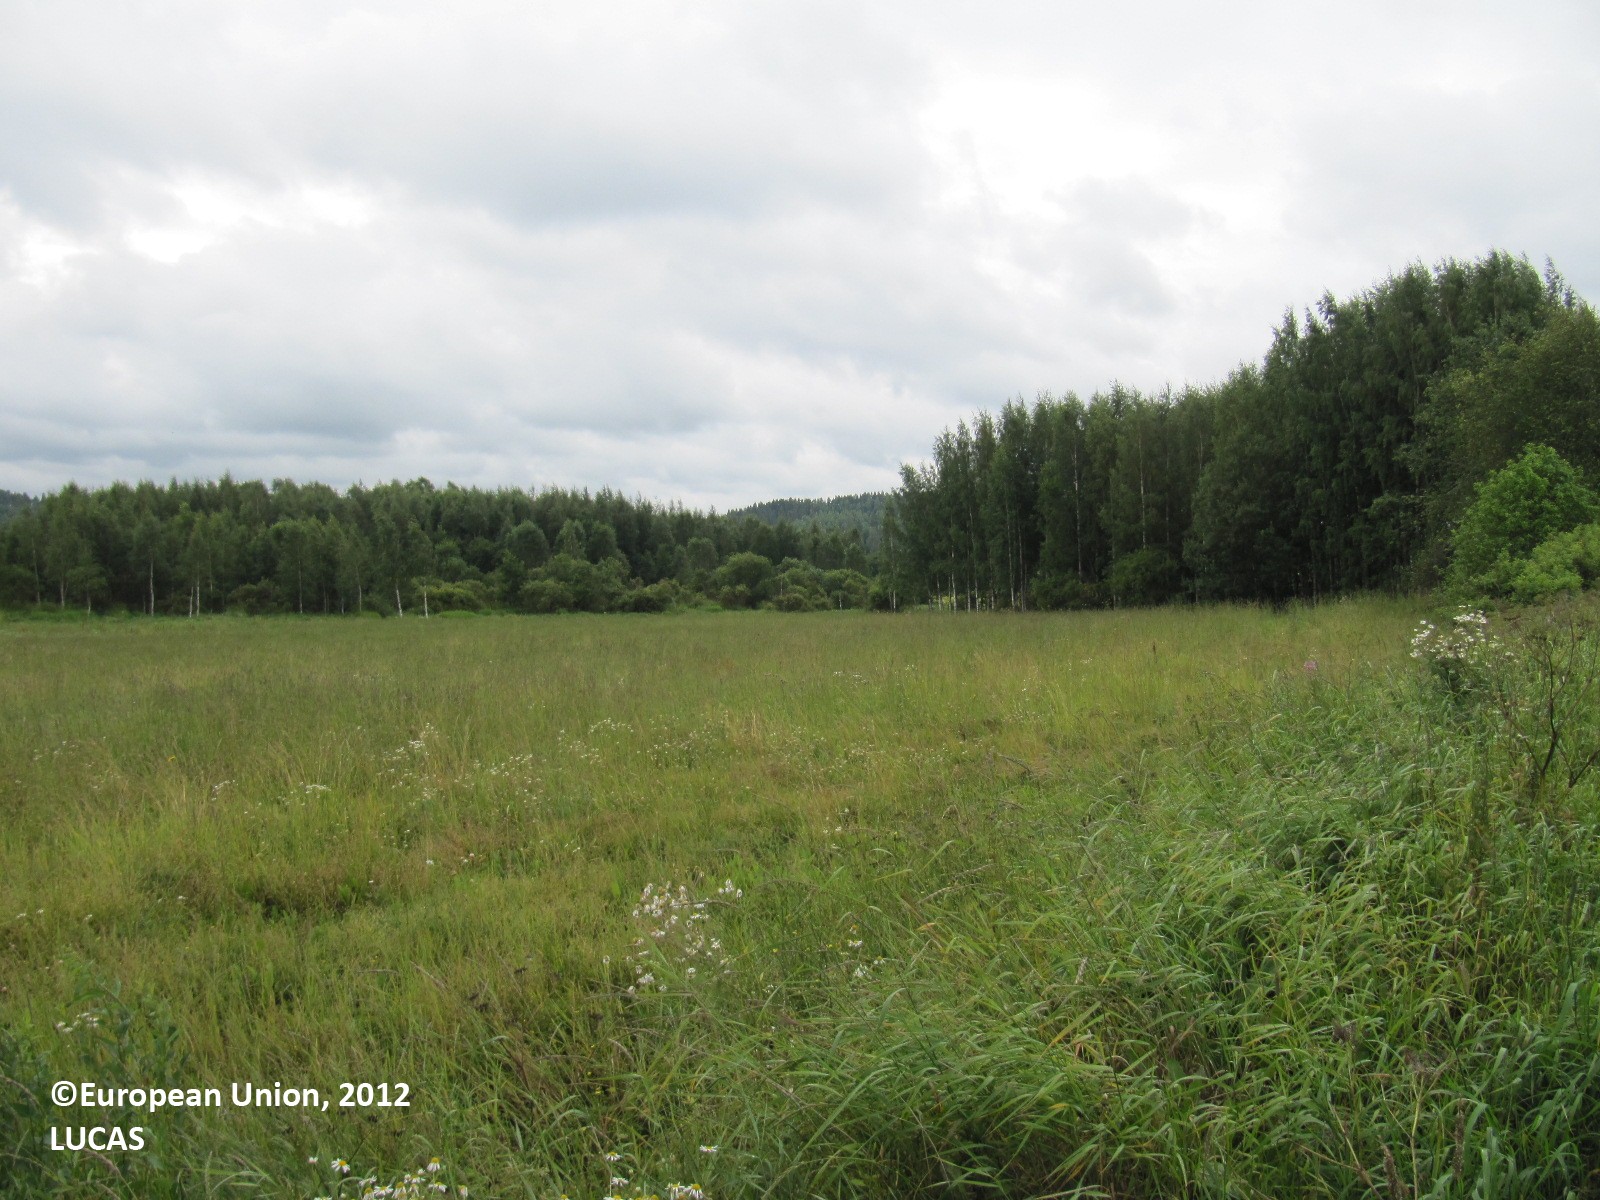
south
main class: Cropland
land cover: Common wheat
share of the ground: > 75 %
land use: Agriculture (excluding fallow land and kitchen gardens)
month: July
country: FI
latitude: 60.4524
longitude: 23.9663
